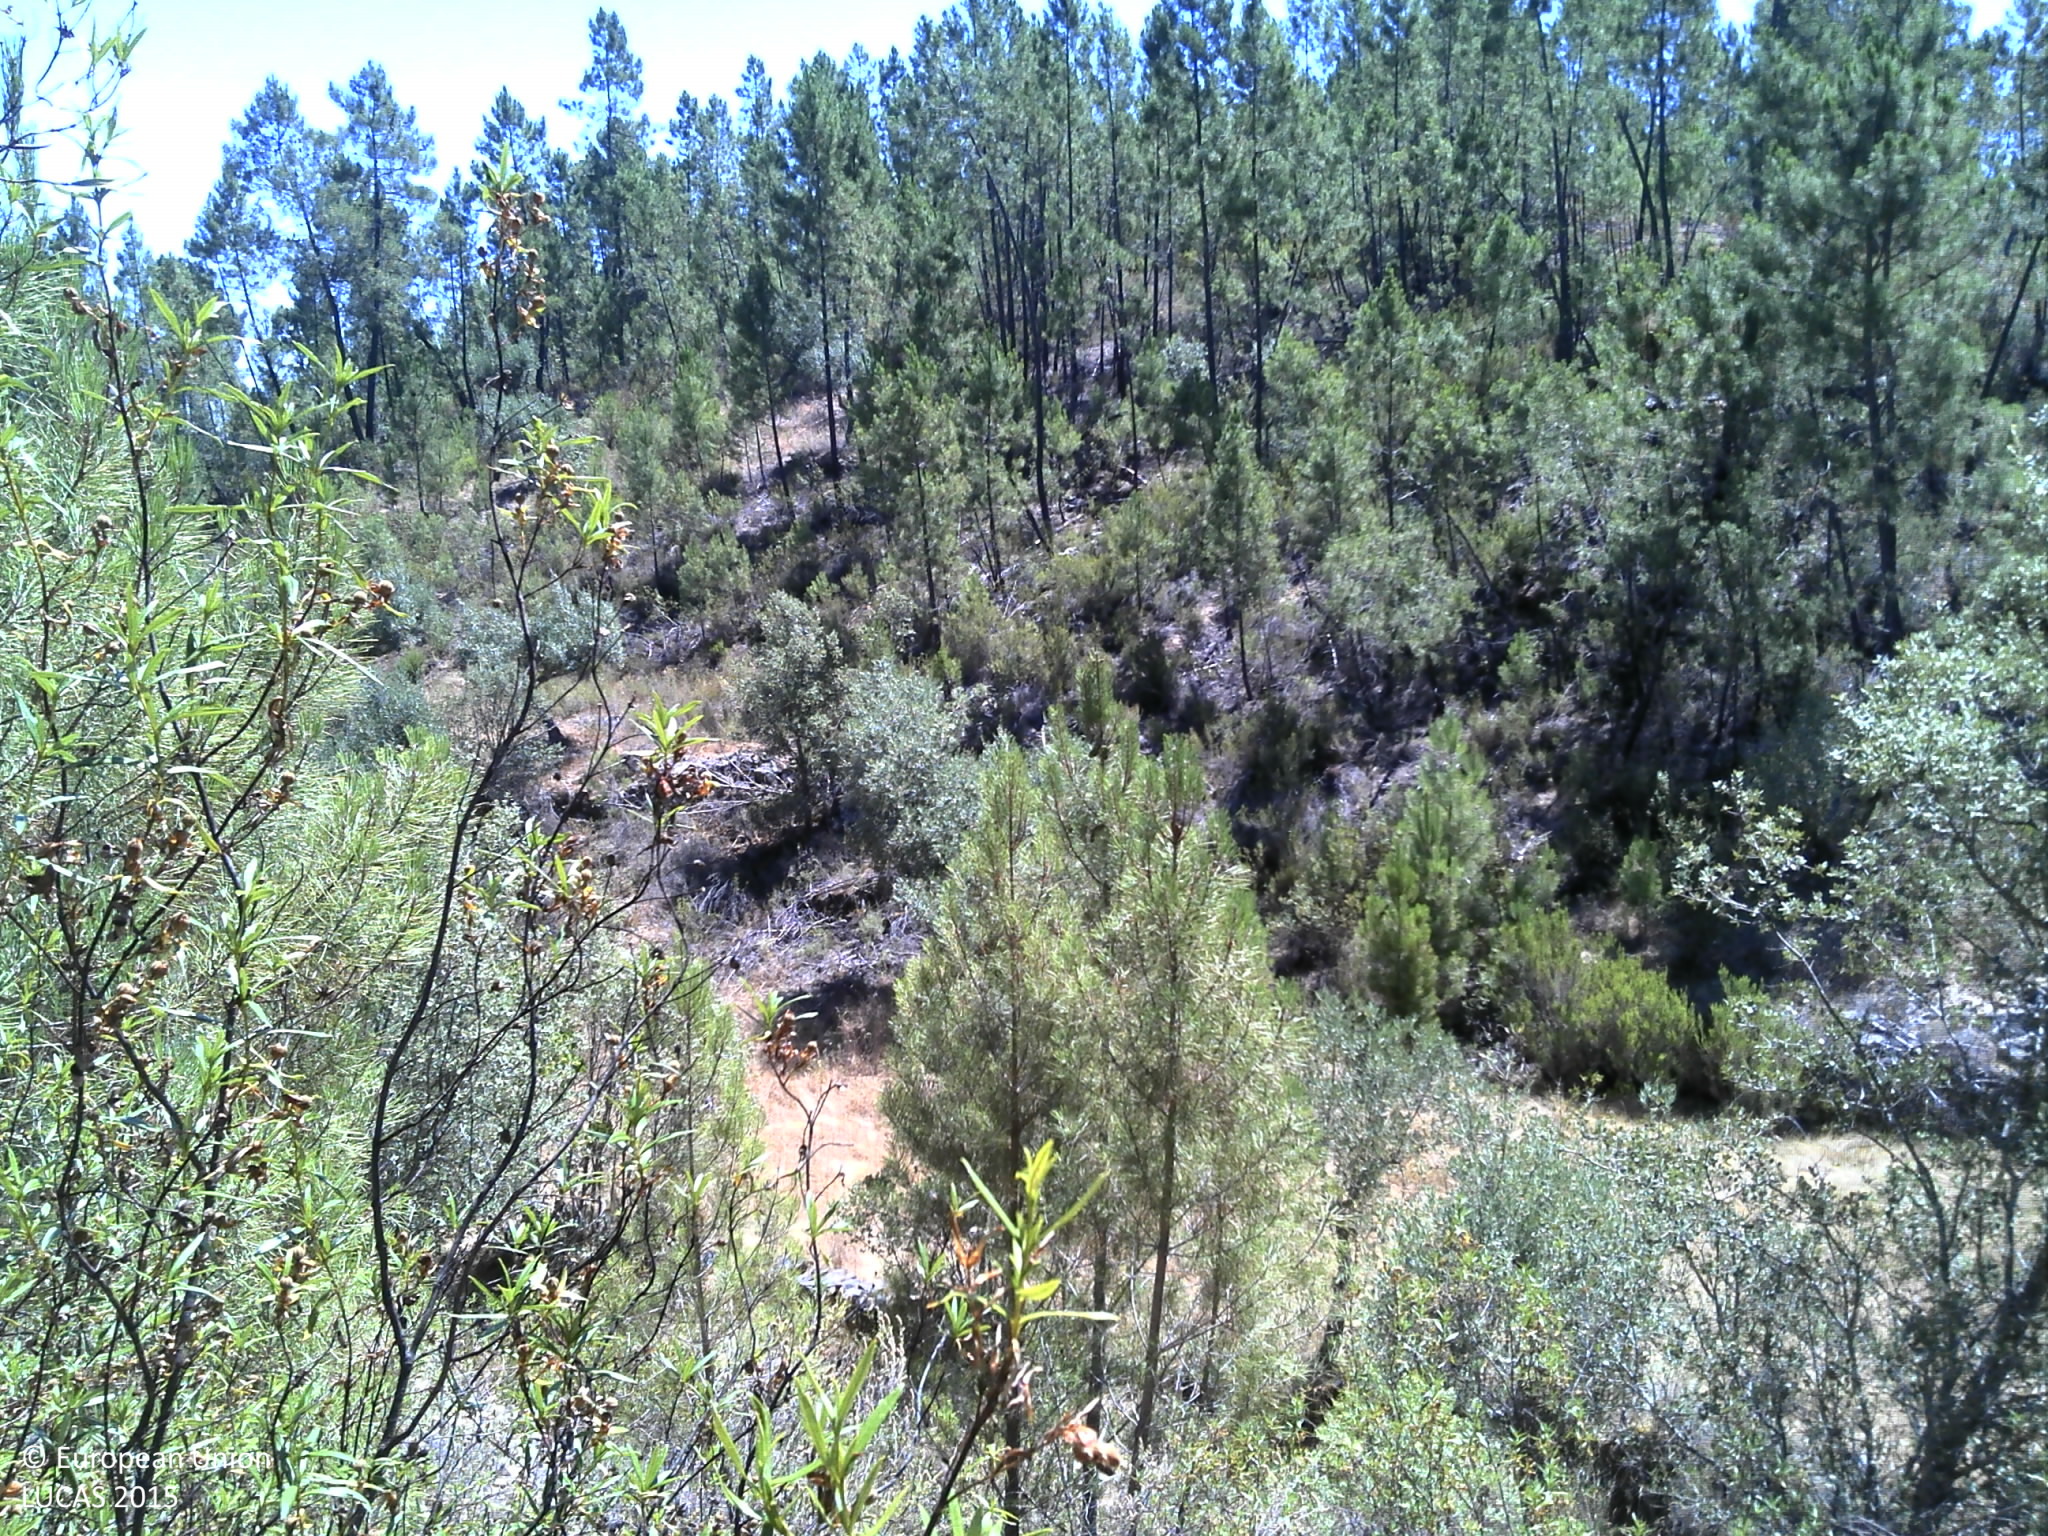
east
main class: Cropland
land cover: Olive groves
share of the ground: < 10 %
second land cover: Shrubland without tree cover
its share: > 75 %
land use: Abandoned areas
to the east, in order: Olive groves; Shrubland without tree cover; Rivers and streams; Dry stone walls; Abandoned hedges; Grassland without tree/shrub cover; Olive groves; Pine dominated coniferous woodland
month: July
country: PT
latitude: 39.7146
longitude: -7.8003
